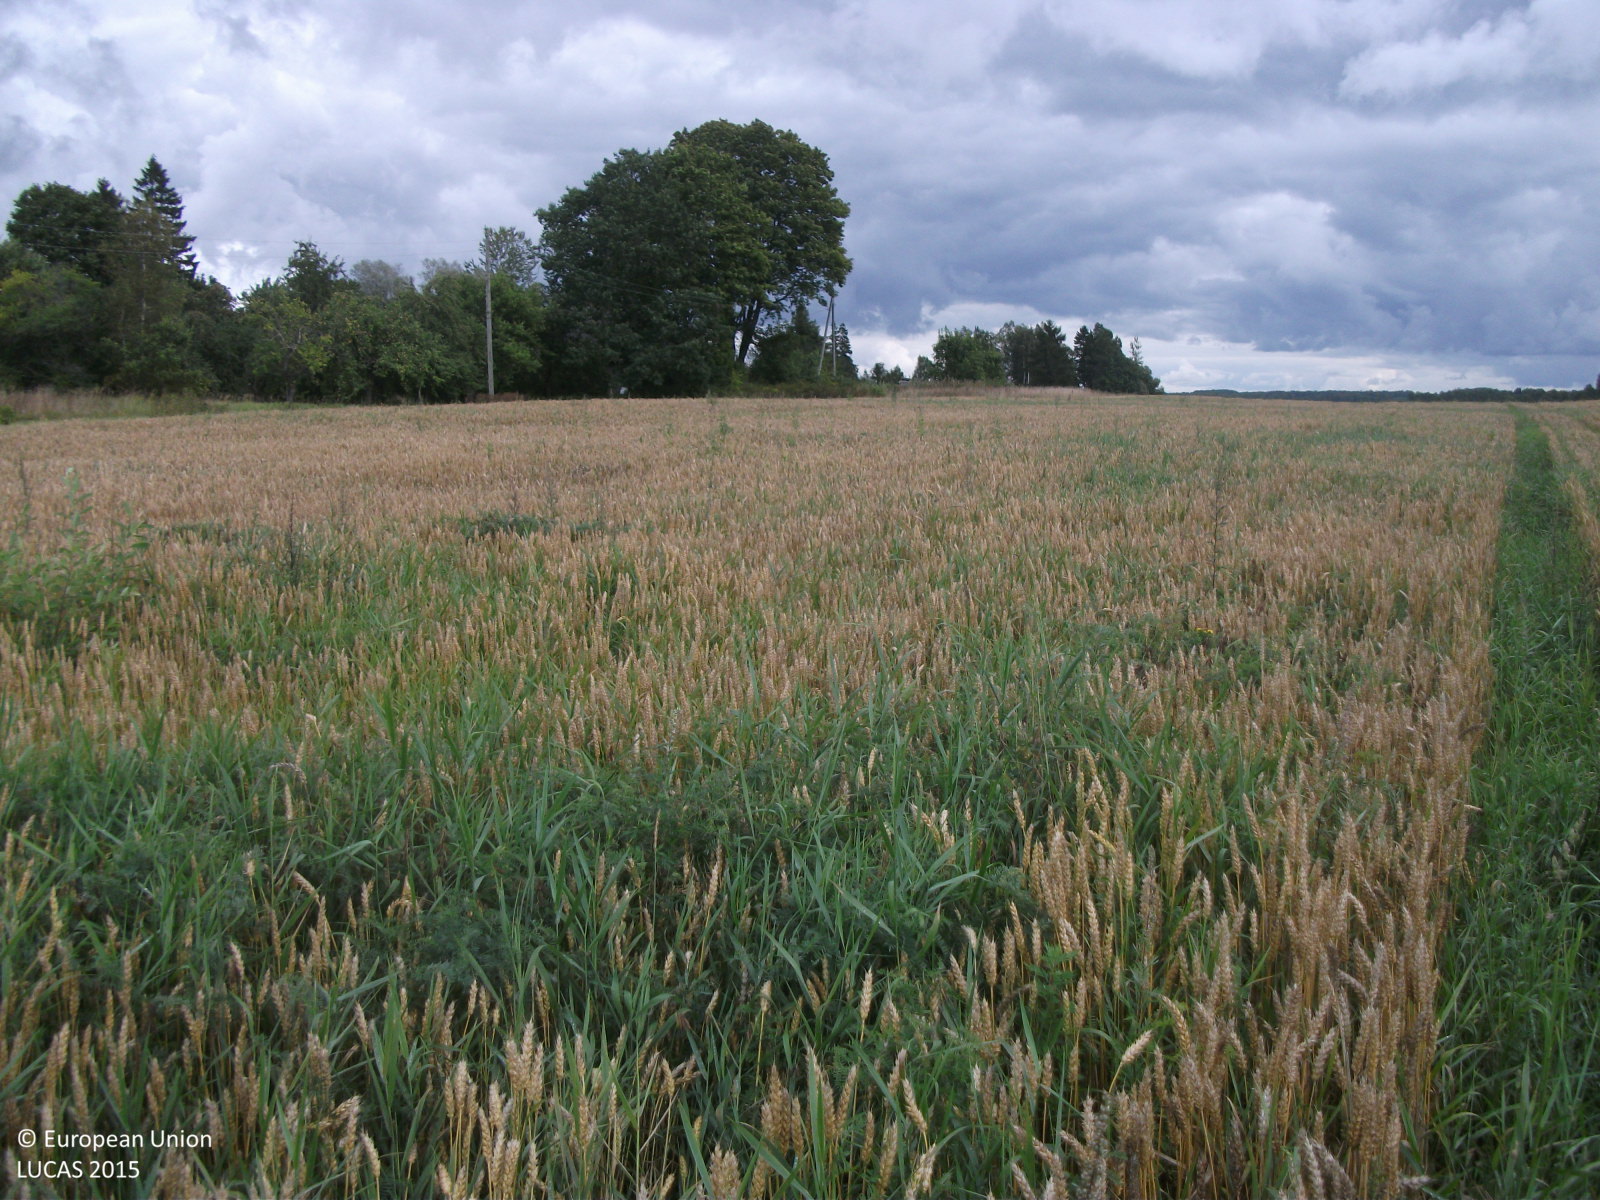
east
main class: Cropland
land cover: Common wheat
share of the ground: > 75 %
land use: Agriculture (excluding fallow land and kitchen gardens)
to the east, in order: Common wheat; Grass margins; Electric lines; Broadleaved woodland; Artificial constructions in urban areas; Spontaneously vegetated surfaces; Abandoned hedges; Common wheat
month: September
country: LV
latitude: 57.6196
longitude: 24.7452
